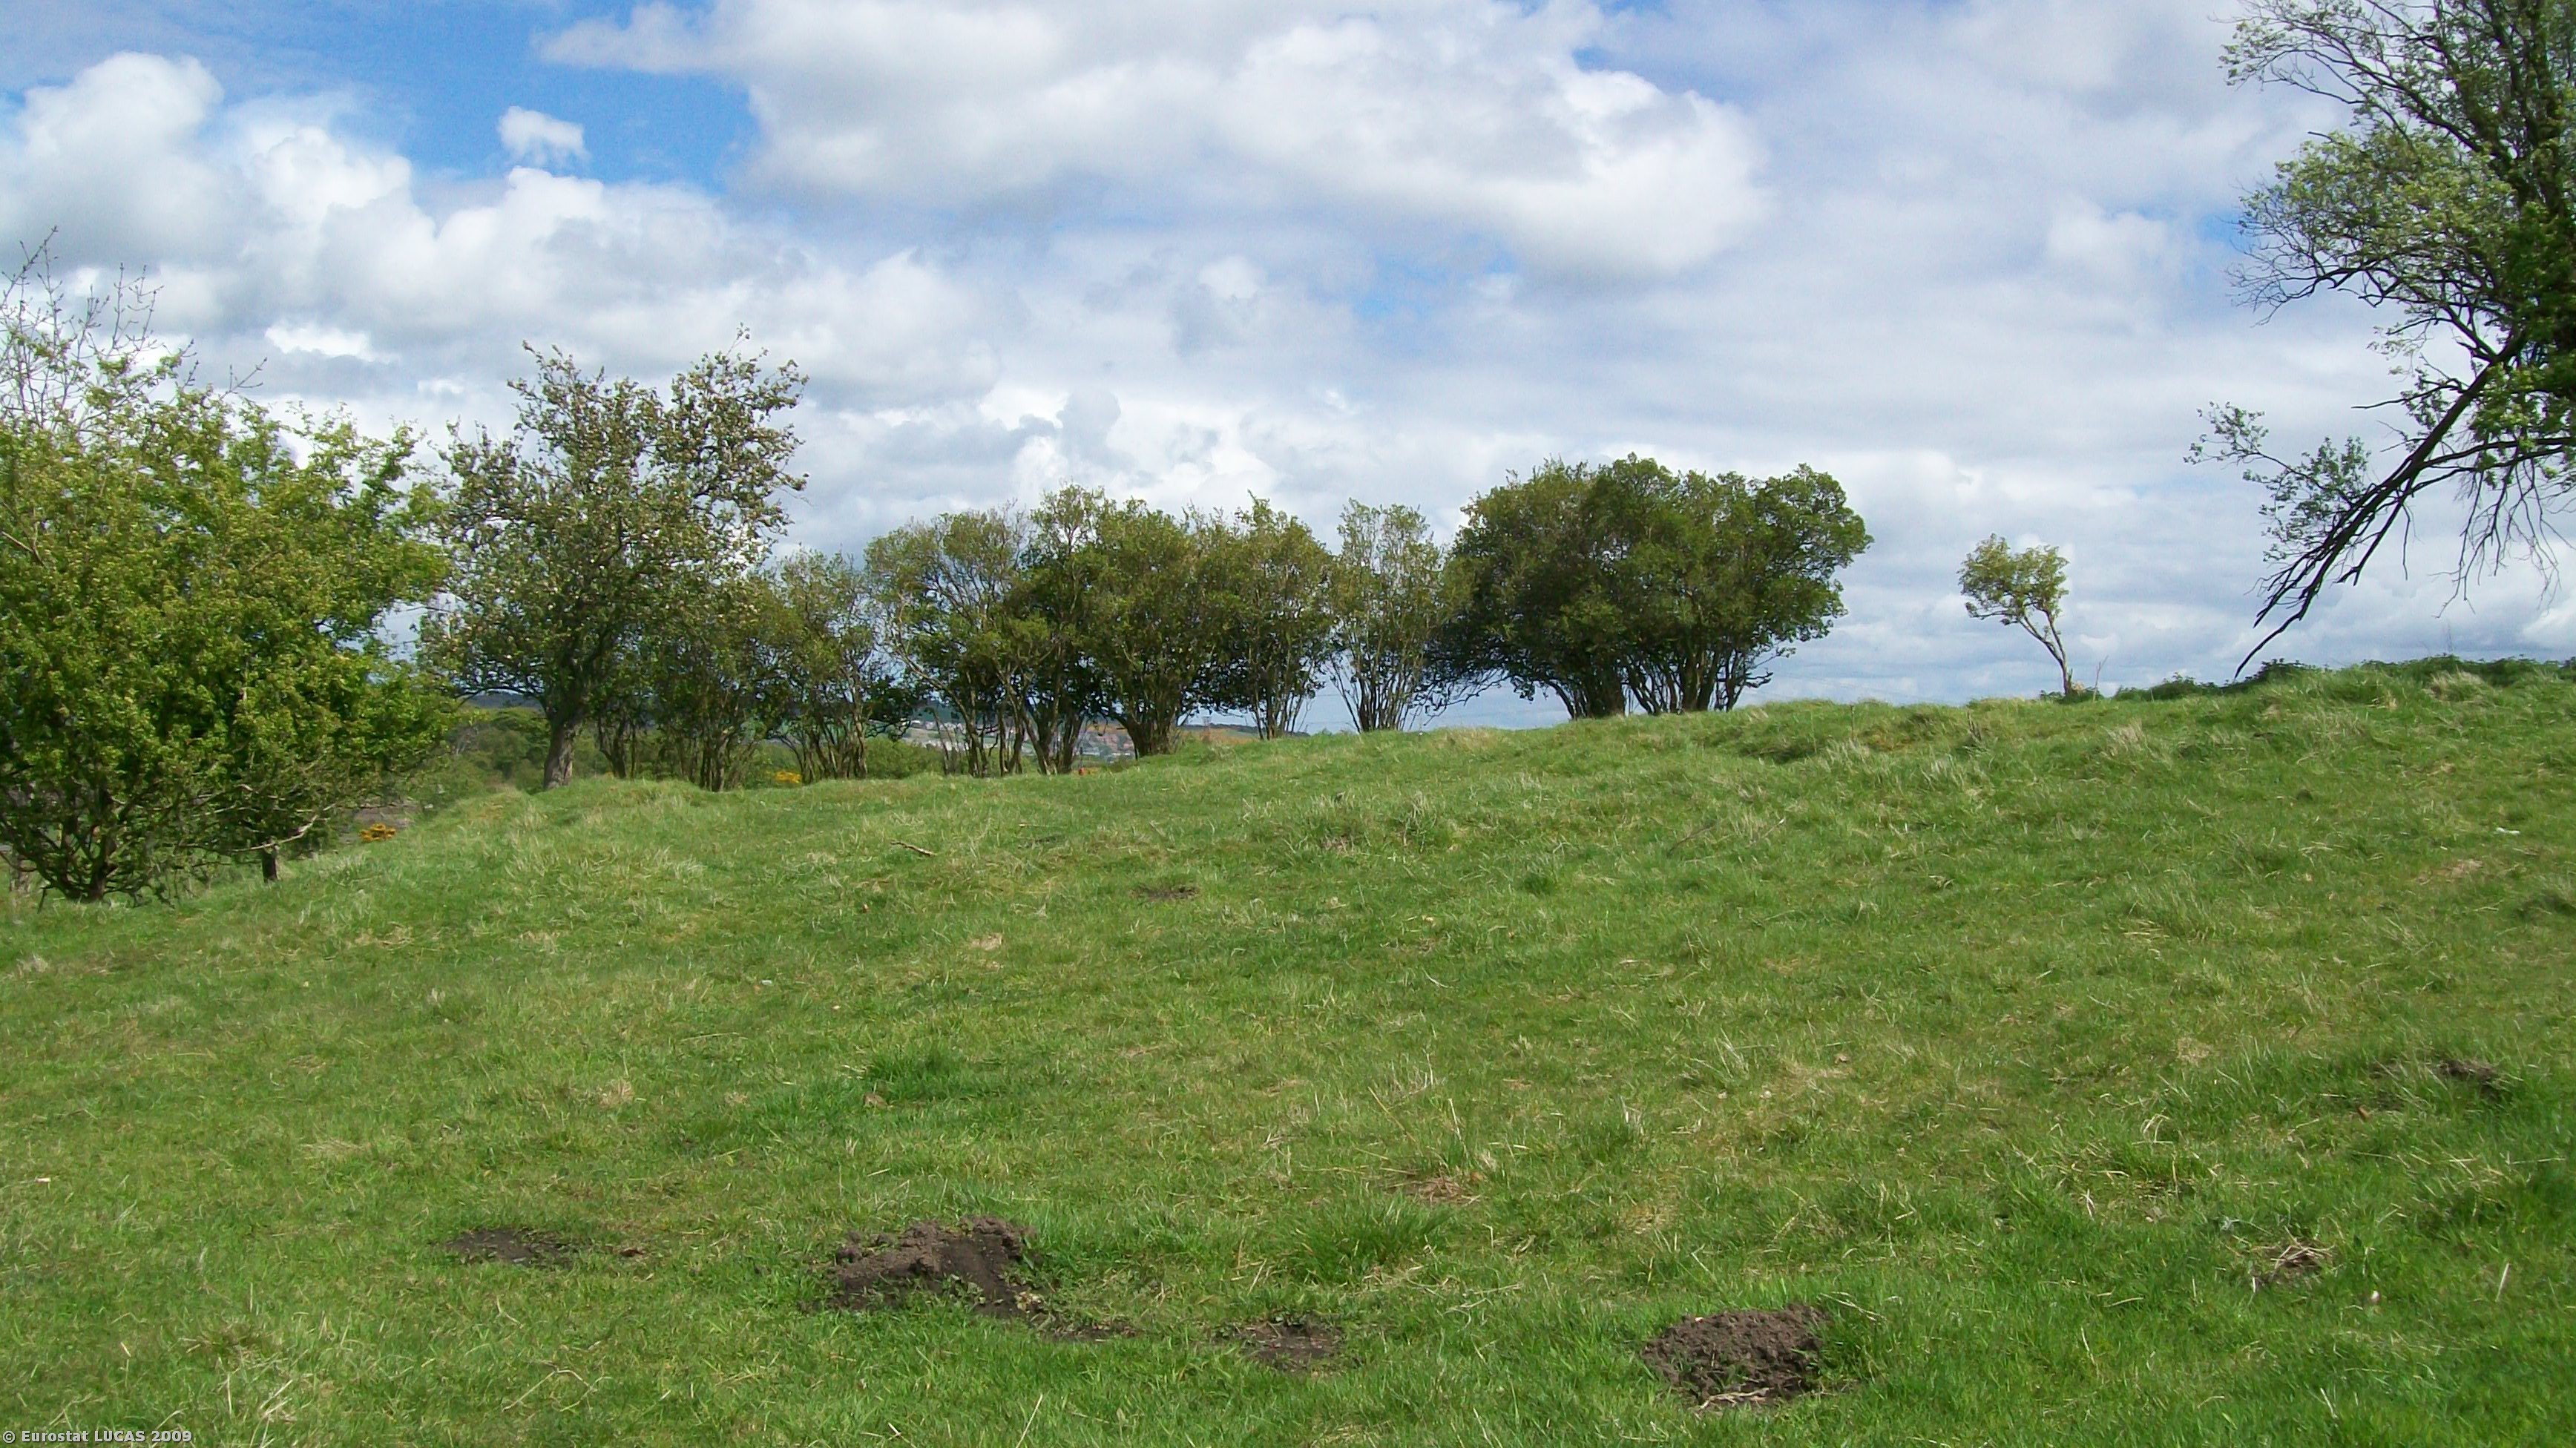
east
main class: Grassland
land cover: Grassland without tree/shrub cover
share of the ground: > 75 %
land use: Agriculture (excluding fallow land and kitchen gardens)
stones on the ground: 10 - 25 %
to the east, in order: Grassland without tree/shrub cover; Managed hedges; Grassland without tree/shrub cover; Fences; Peatbogs; Shrubland with sparse tree cover
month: May
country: GB
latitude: 55.8880
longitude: -3.6875
